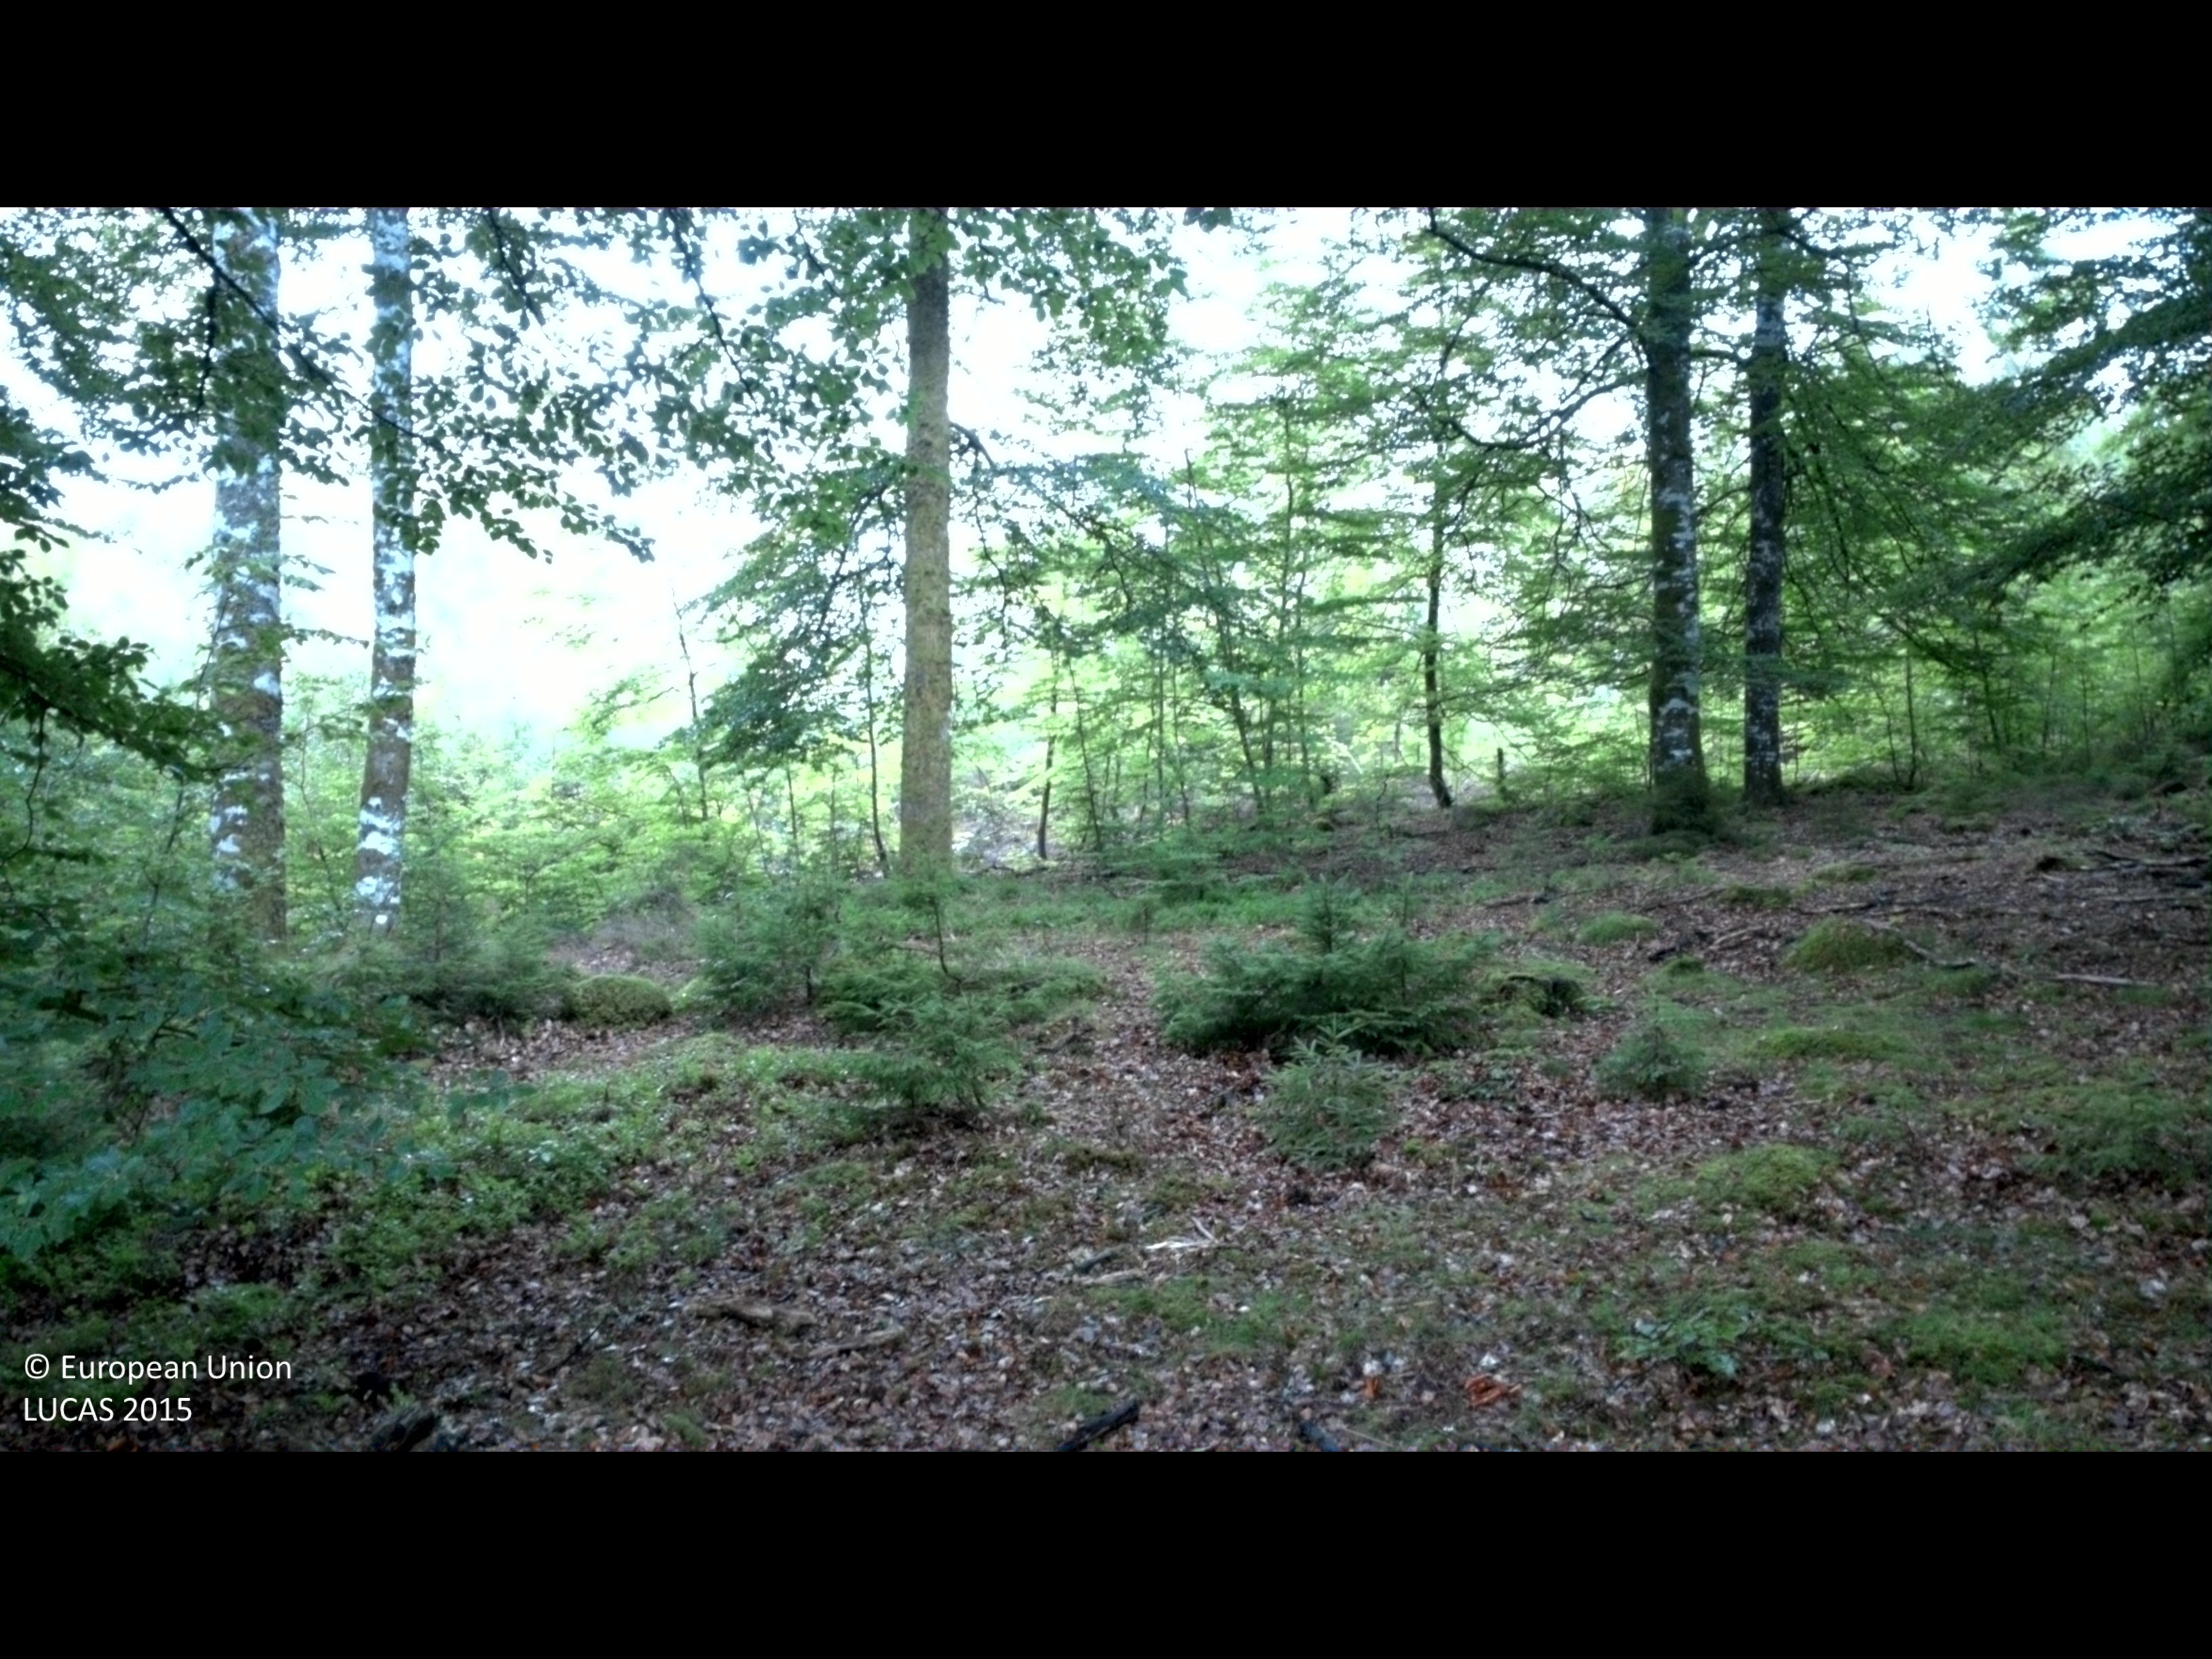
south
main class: Woodland
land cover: Broadleaved woodland
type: beech forest
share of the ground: > 75 %
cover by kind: broadleaved forest trees 75 %, lichens and mosses 5 %
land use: Forestry
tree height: > 5 m
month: August
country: SE
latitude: 57.1372
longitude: 13.8791
